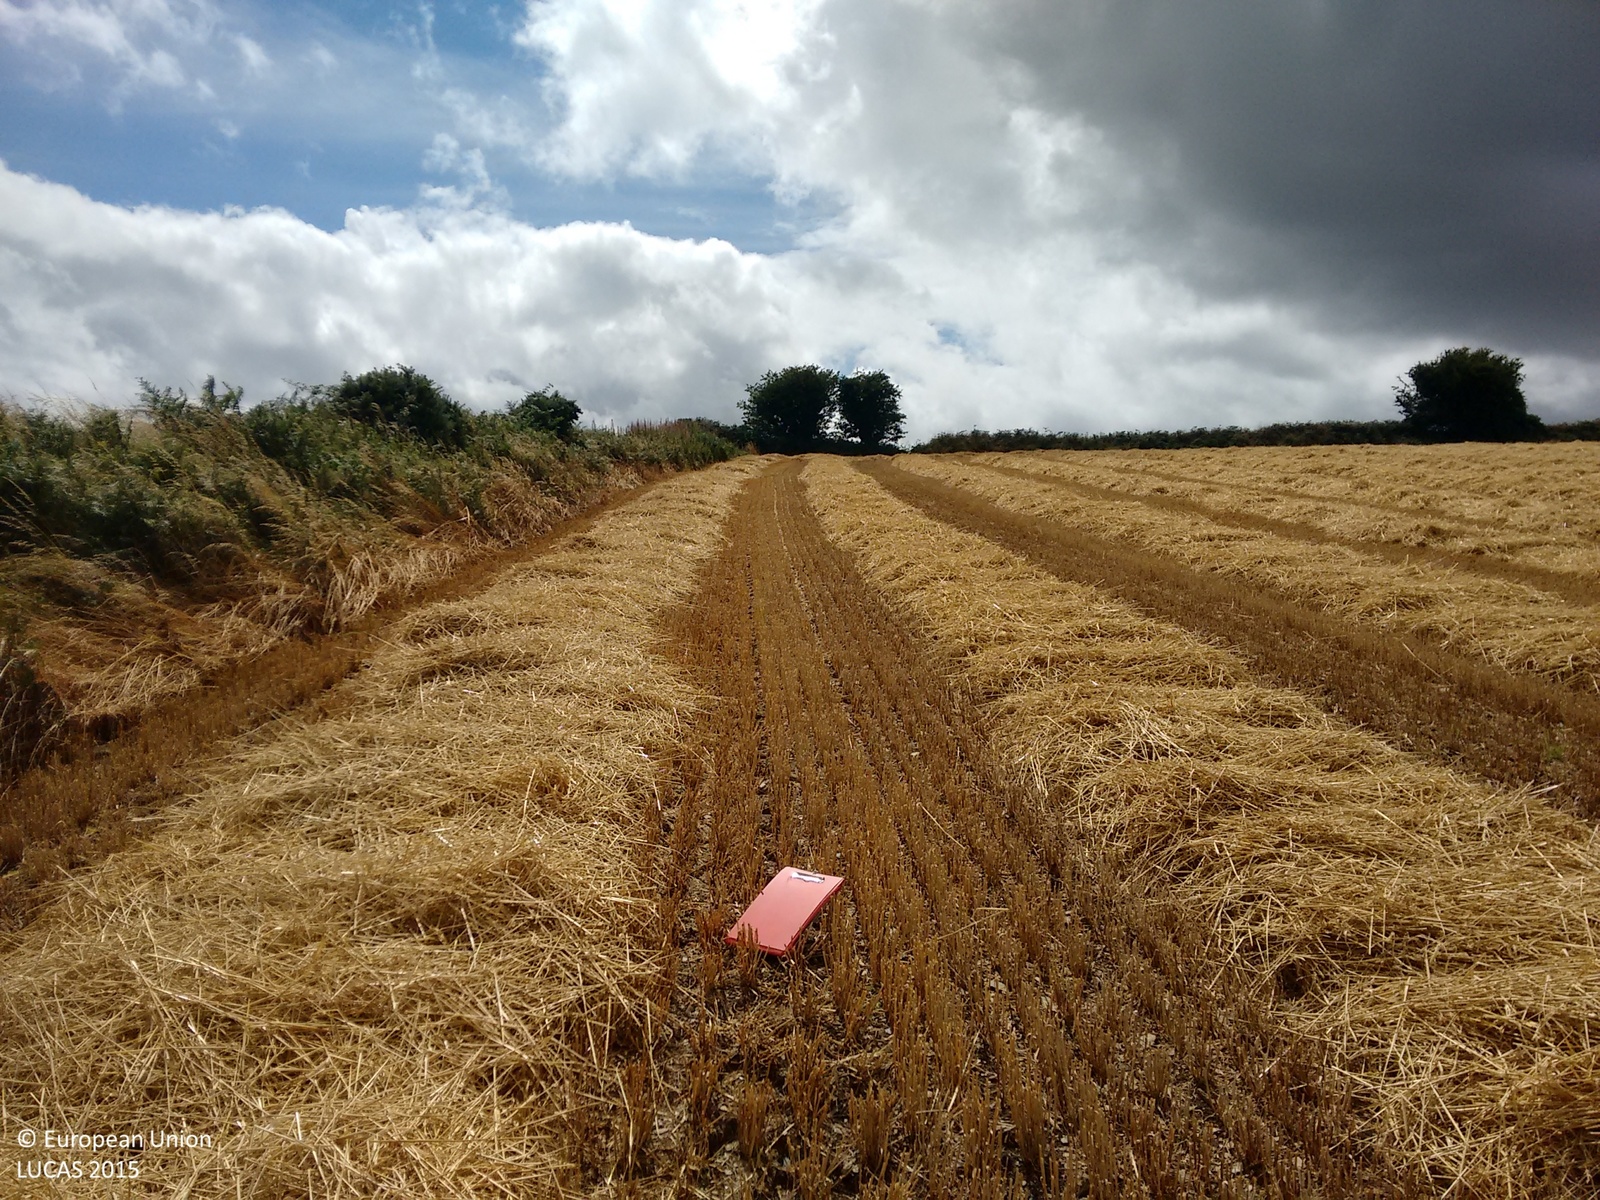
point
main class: Cropland
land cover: Barley
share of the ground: > 75 %
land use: Agriculture (excluding fallow land and kitchen gardens)
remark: Harvested field
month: August
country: IE
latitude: 52.6715
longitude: -6.4375
